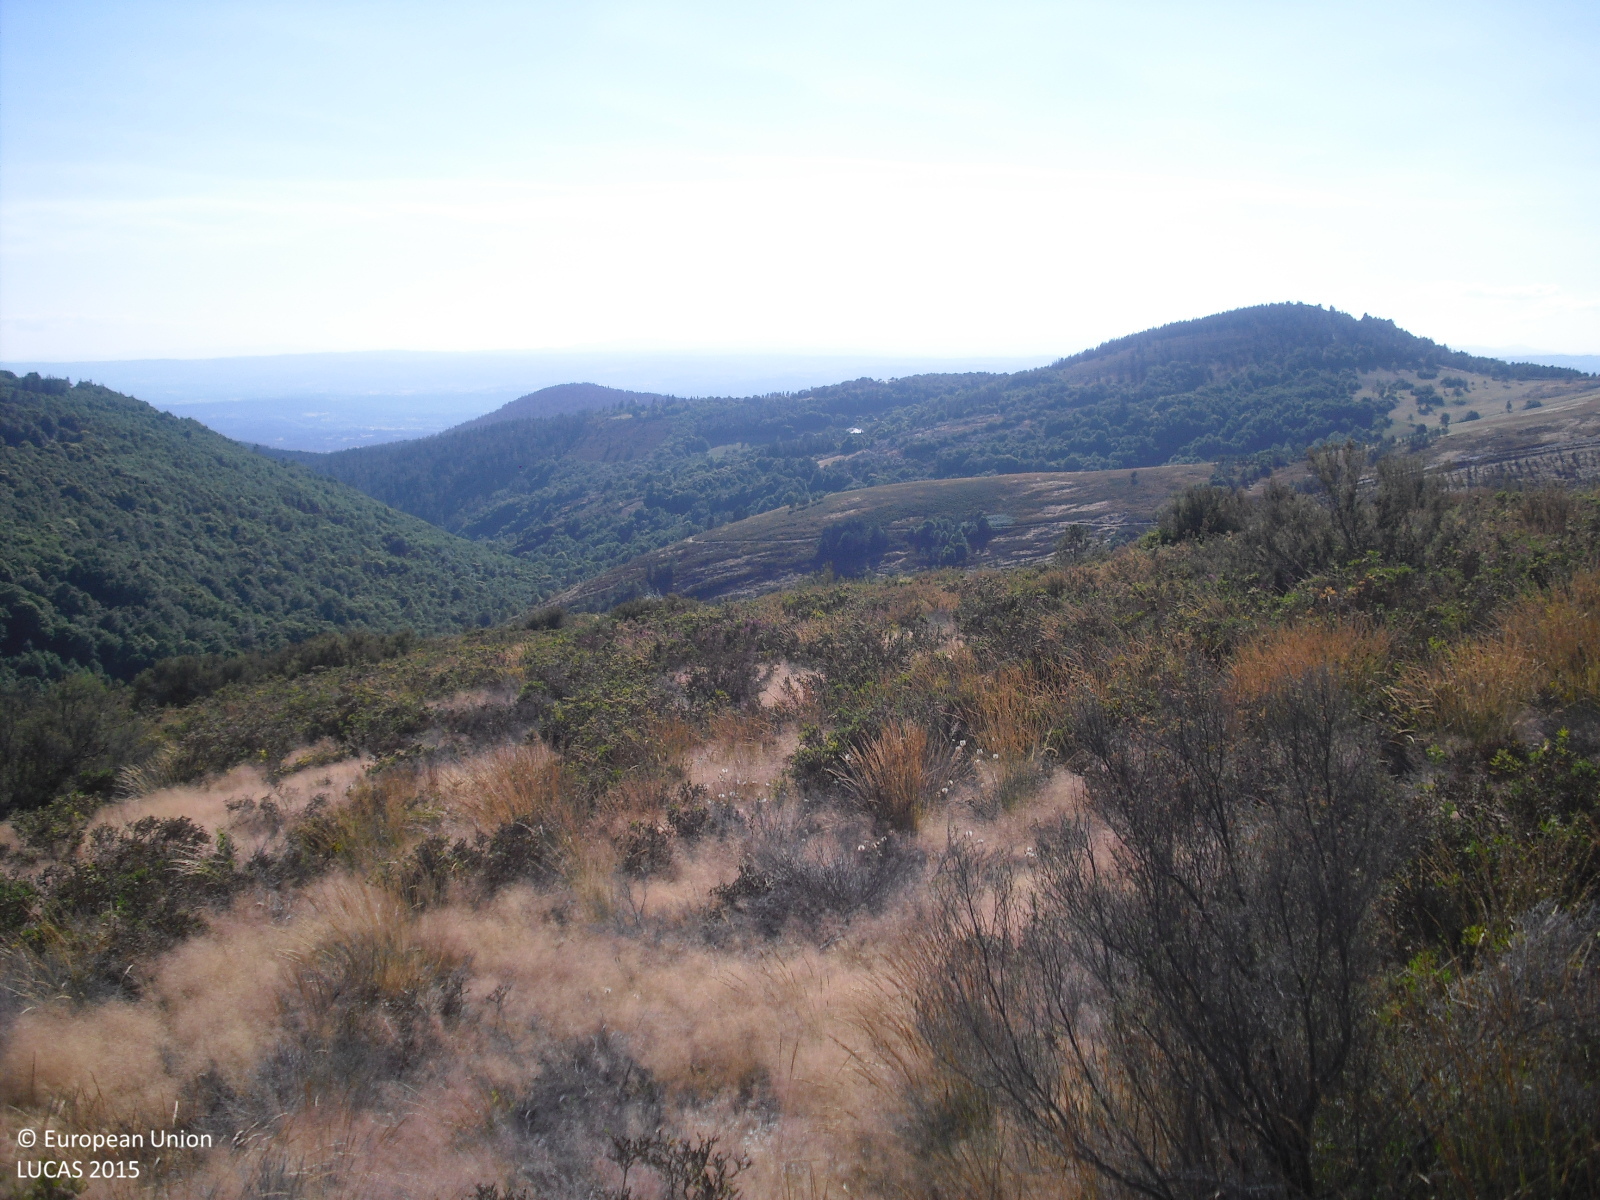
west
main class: Shrubland
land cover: Shrubland without tree cover
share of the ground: > 75 %
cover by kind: shrubs 70 %, herbaceous plants 20 %, consolidated bare surface 5 %, unconsolidated bare surface 5 %
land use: Semi-natural and natural areas not in use
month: July
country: ES
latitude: 42.6229
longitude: -7.3181
